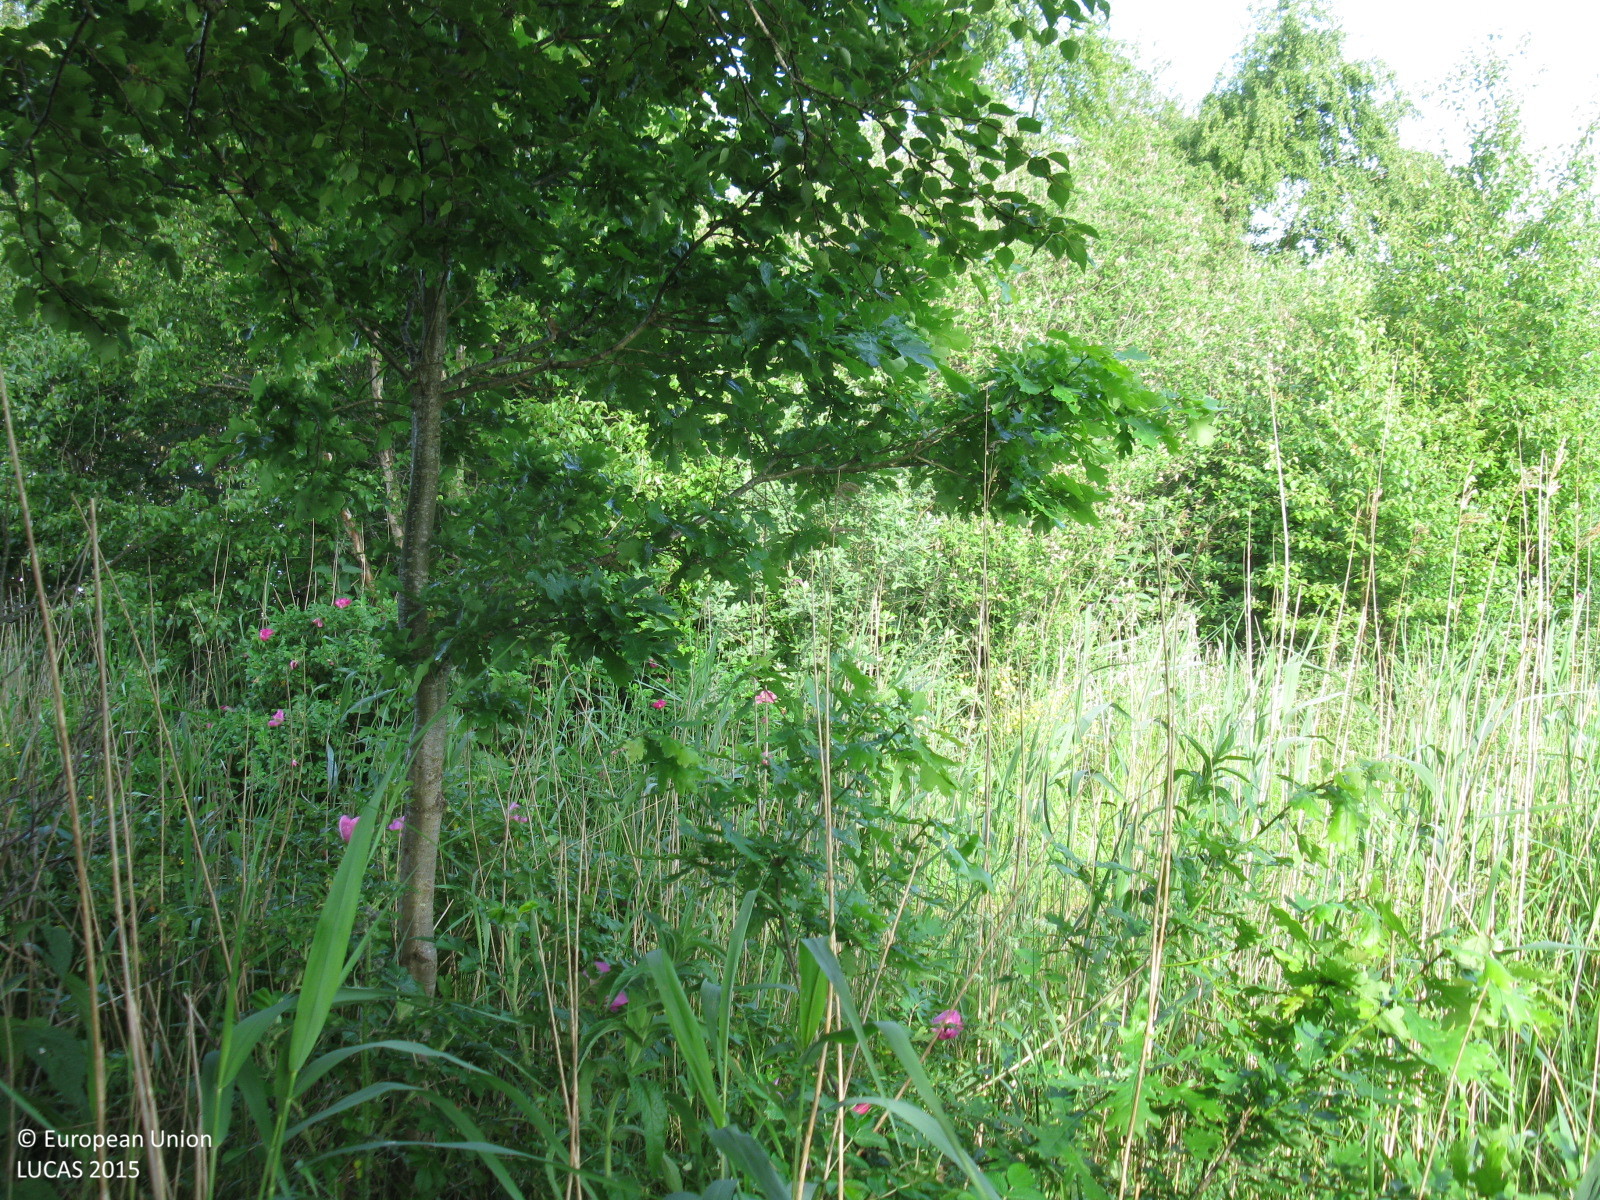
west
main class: Woodland
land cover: Broadleaved woodland
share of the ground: > 75 %
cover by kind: broadleaved forest trees 100 %
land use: Commerce
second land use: Amenities, museums, leisure
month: June
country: DE
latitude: 53.4439
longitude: 7.3057
